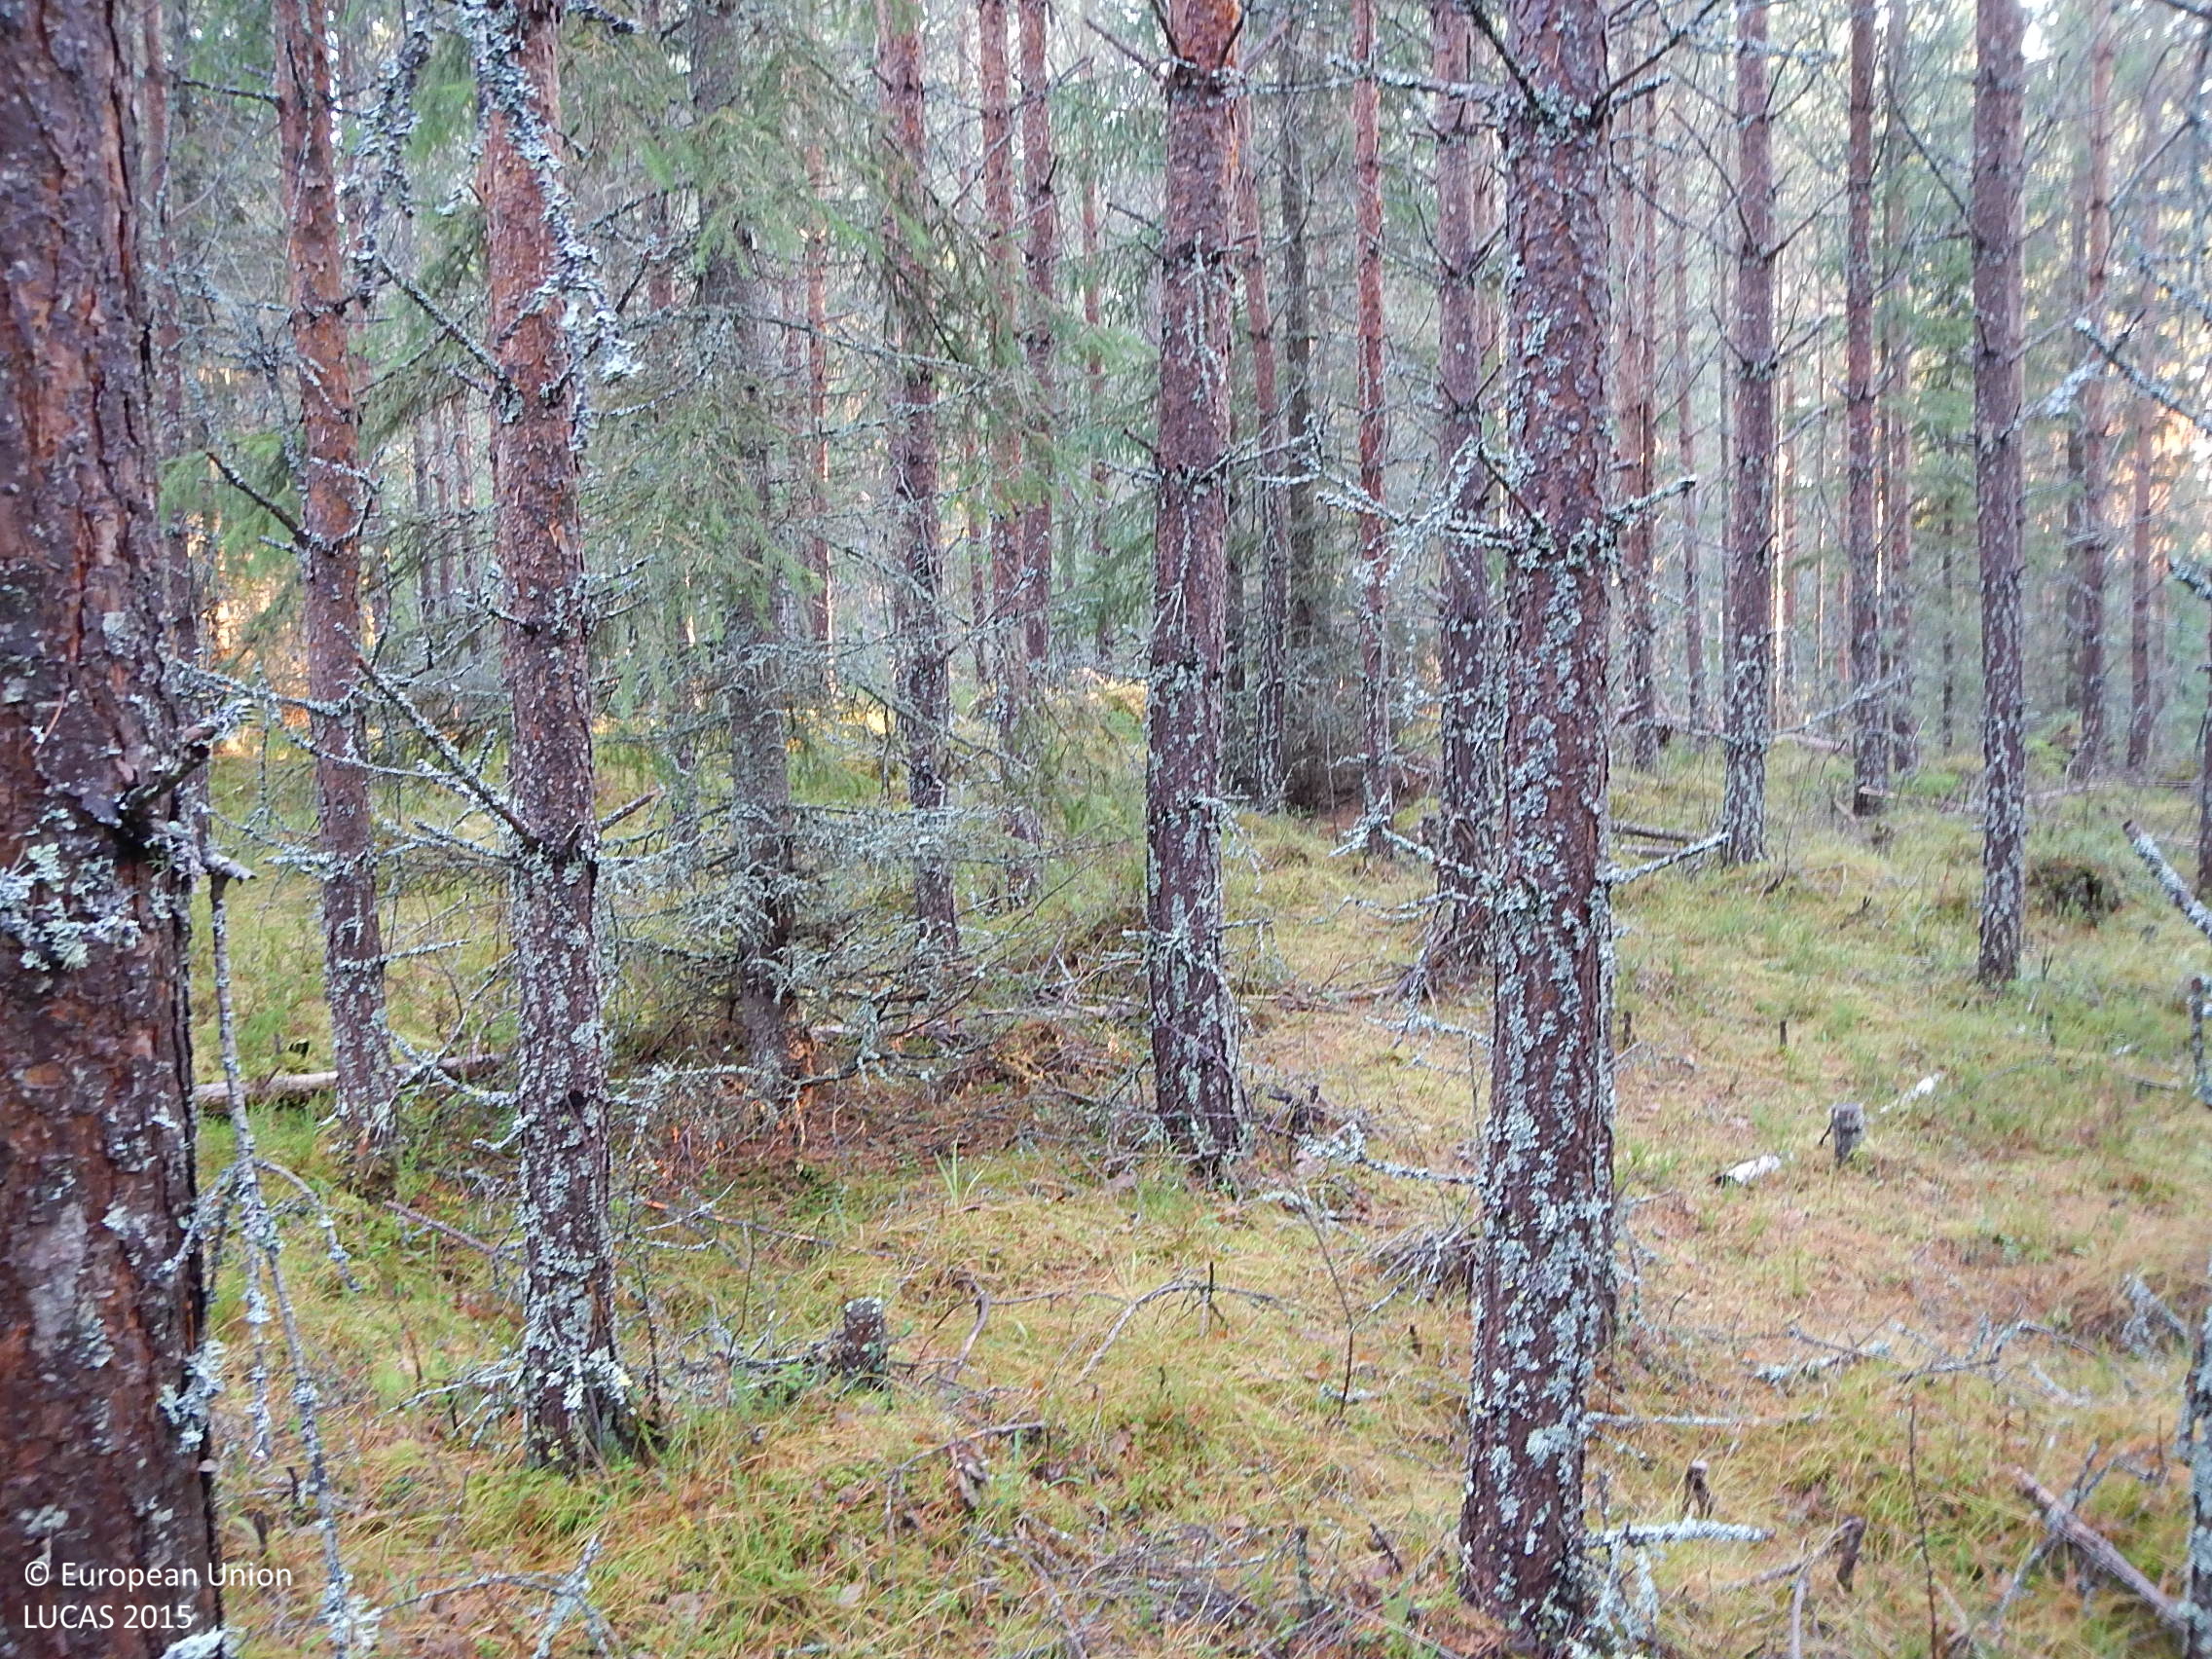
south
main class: Woodland
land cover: Pine dominated coniferous woodland
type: boreal forest
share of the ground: > 75 %
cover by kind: coniferous forest trees 85 %, lichens and mosses 10 %, herbaceous plants 5 %
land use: Forestry
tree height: > 5 m
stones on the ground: < 10 %
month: November
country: SE
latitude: 61.5786
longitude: 15.8033
